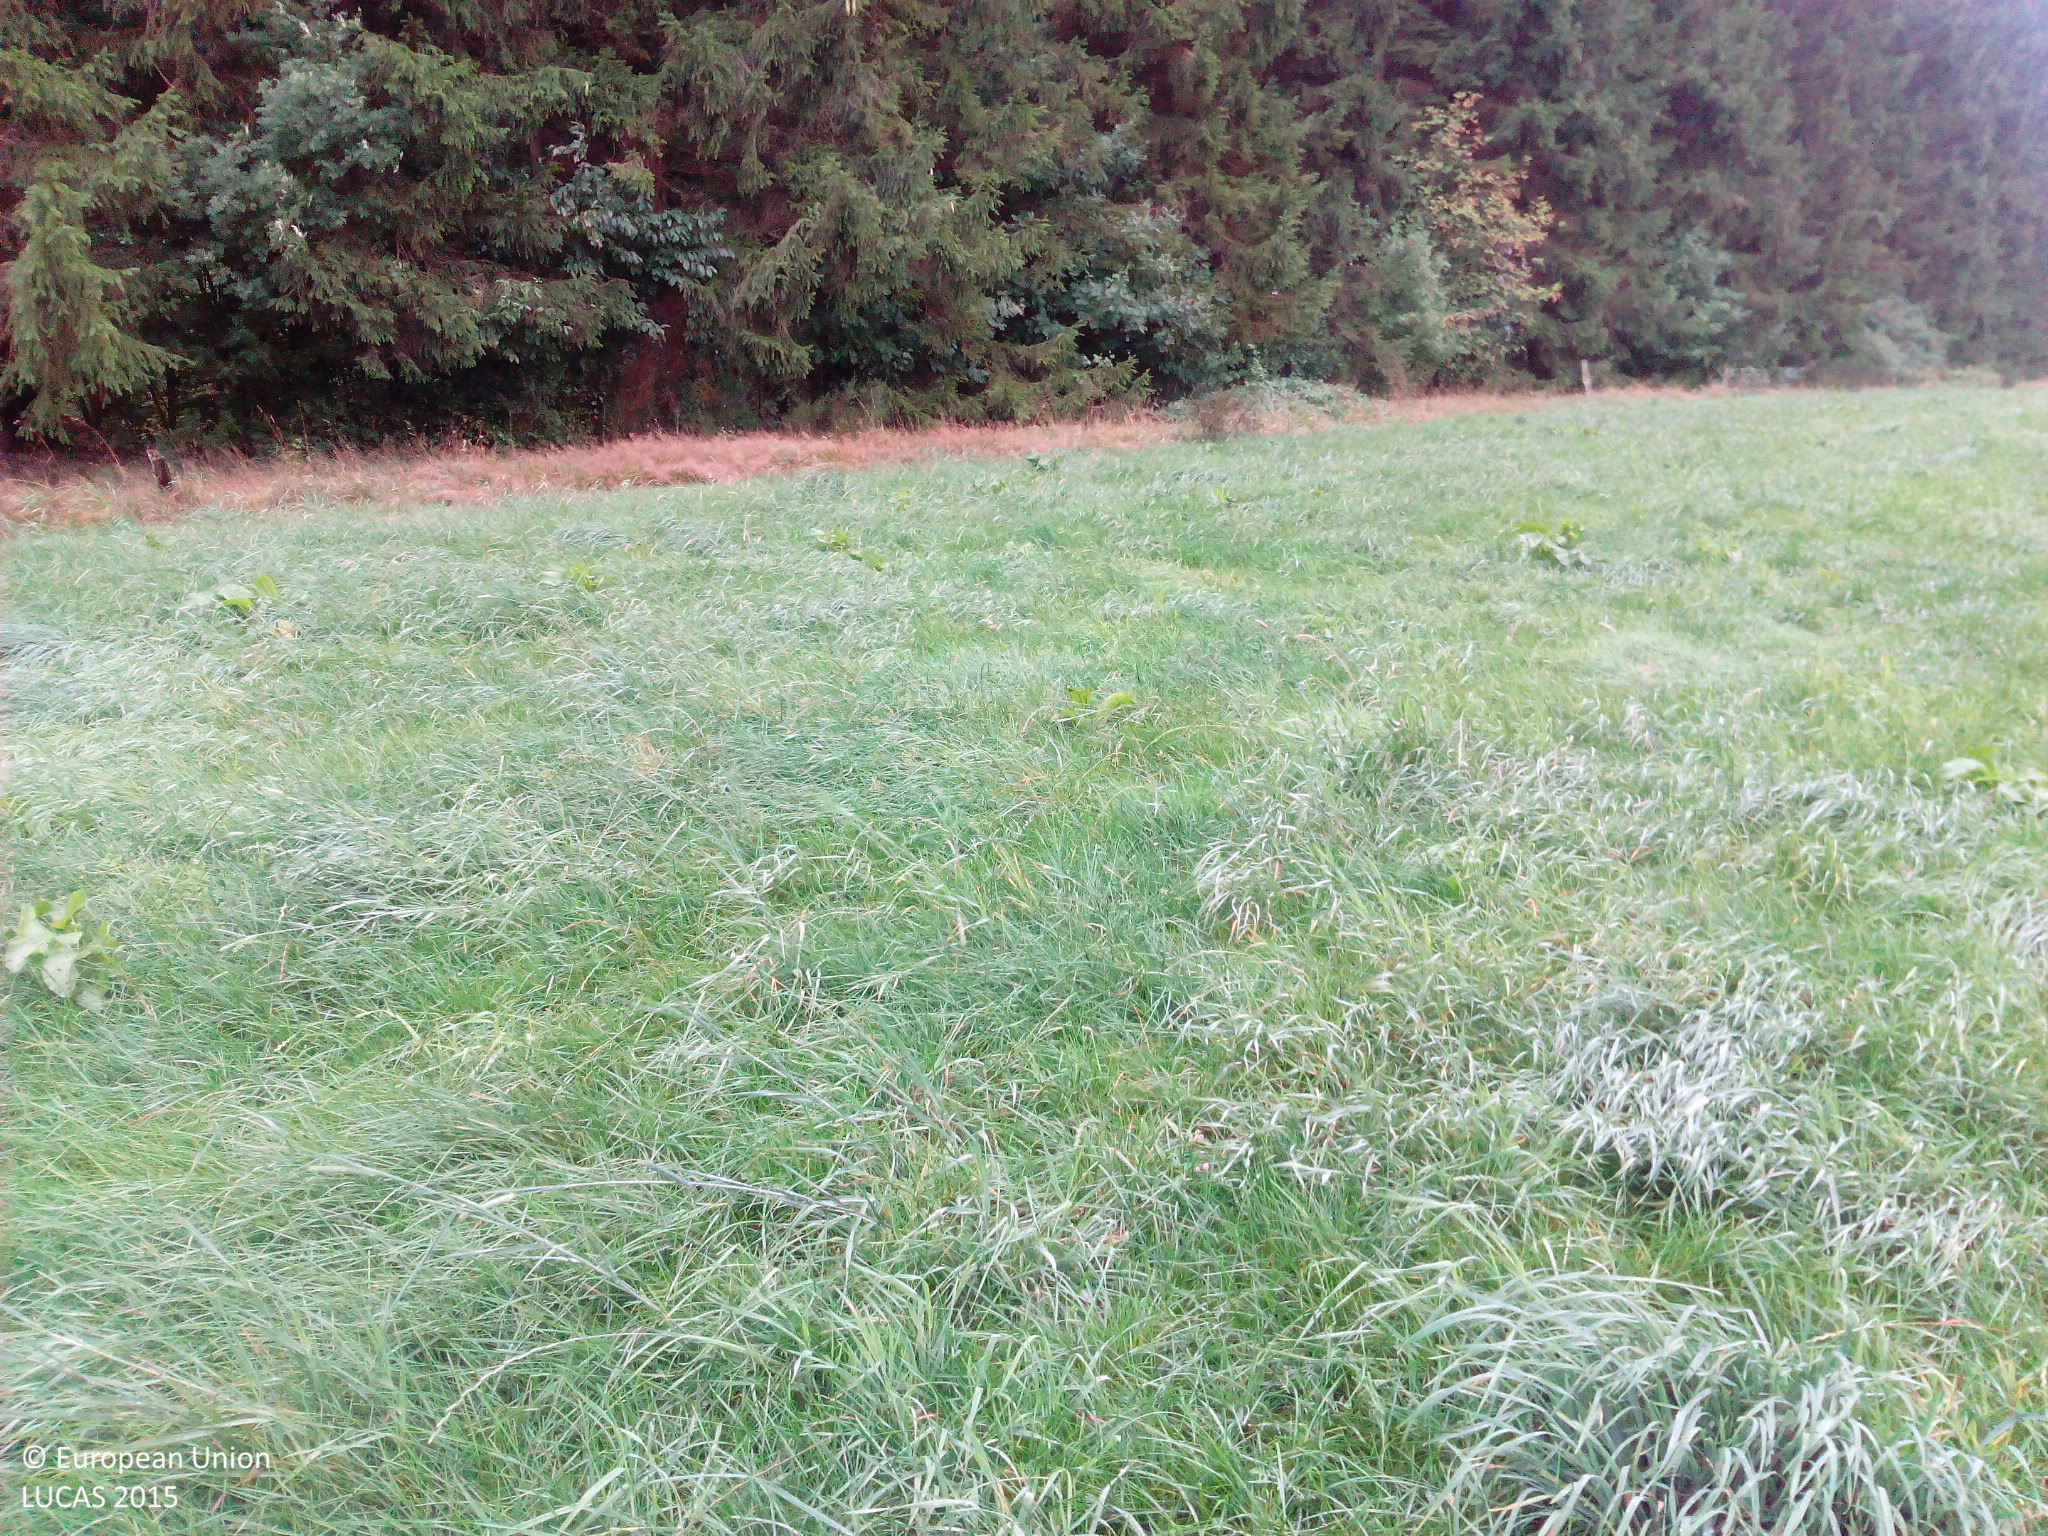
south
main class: Grassland
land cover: Grassland without tree/shrub cover
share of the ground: > 75 %
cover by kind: herbaceous plants 100 %
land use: Agriculture (excluding fallow land and kitchen gardens)
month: August
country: DE
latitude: 50.0881
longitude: 6.2956
